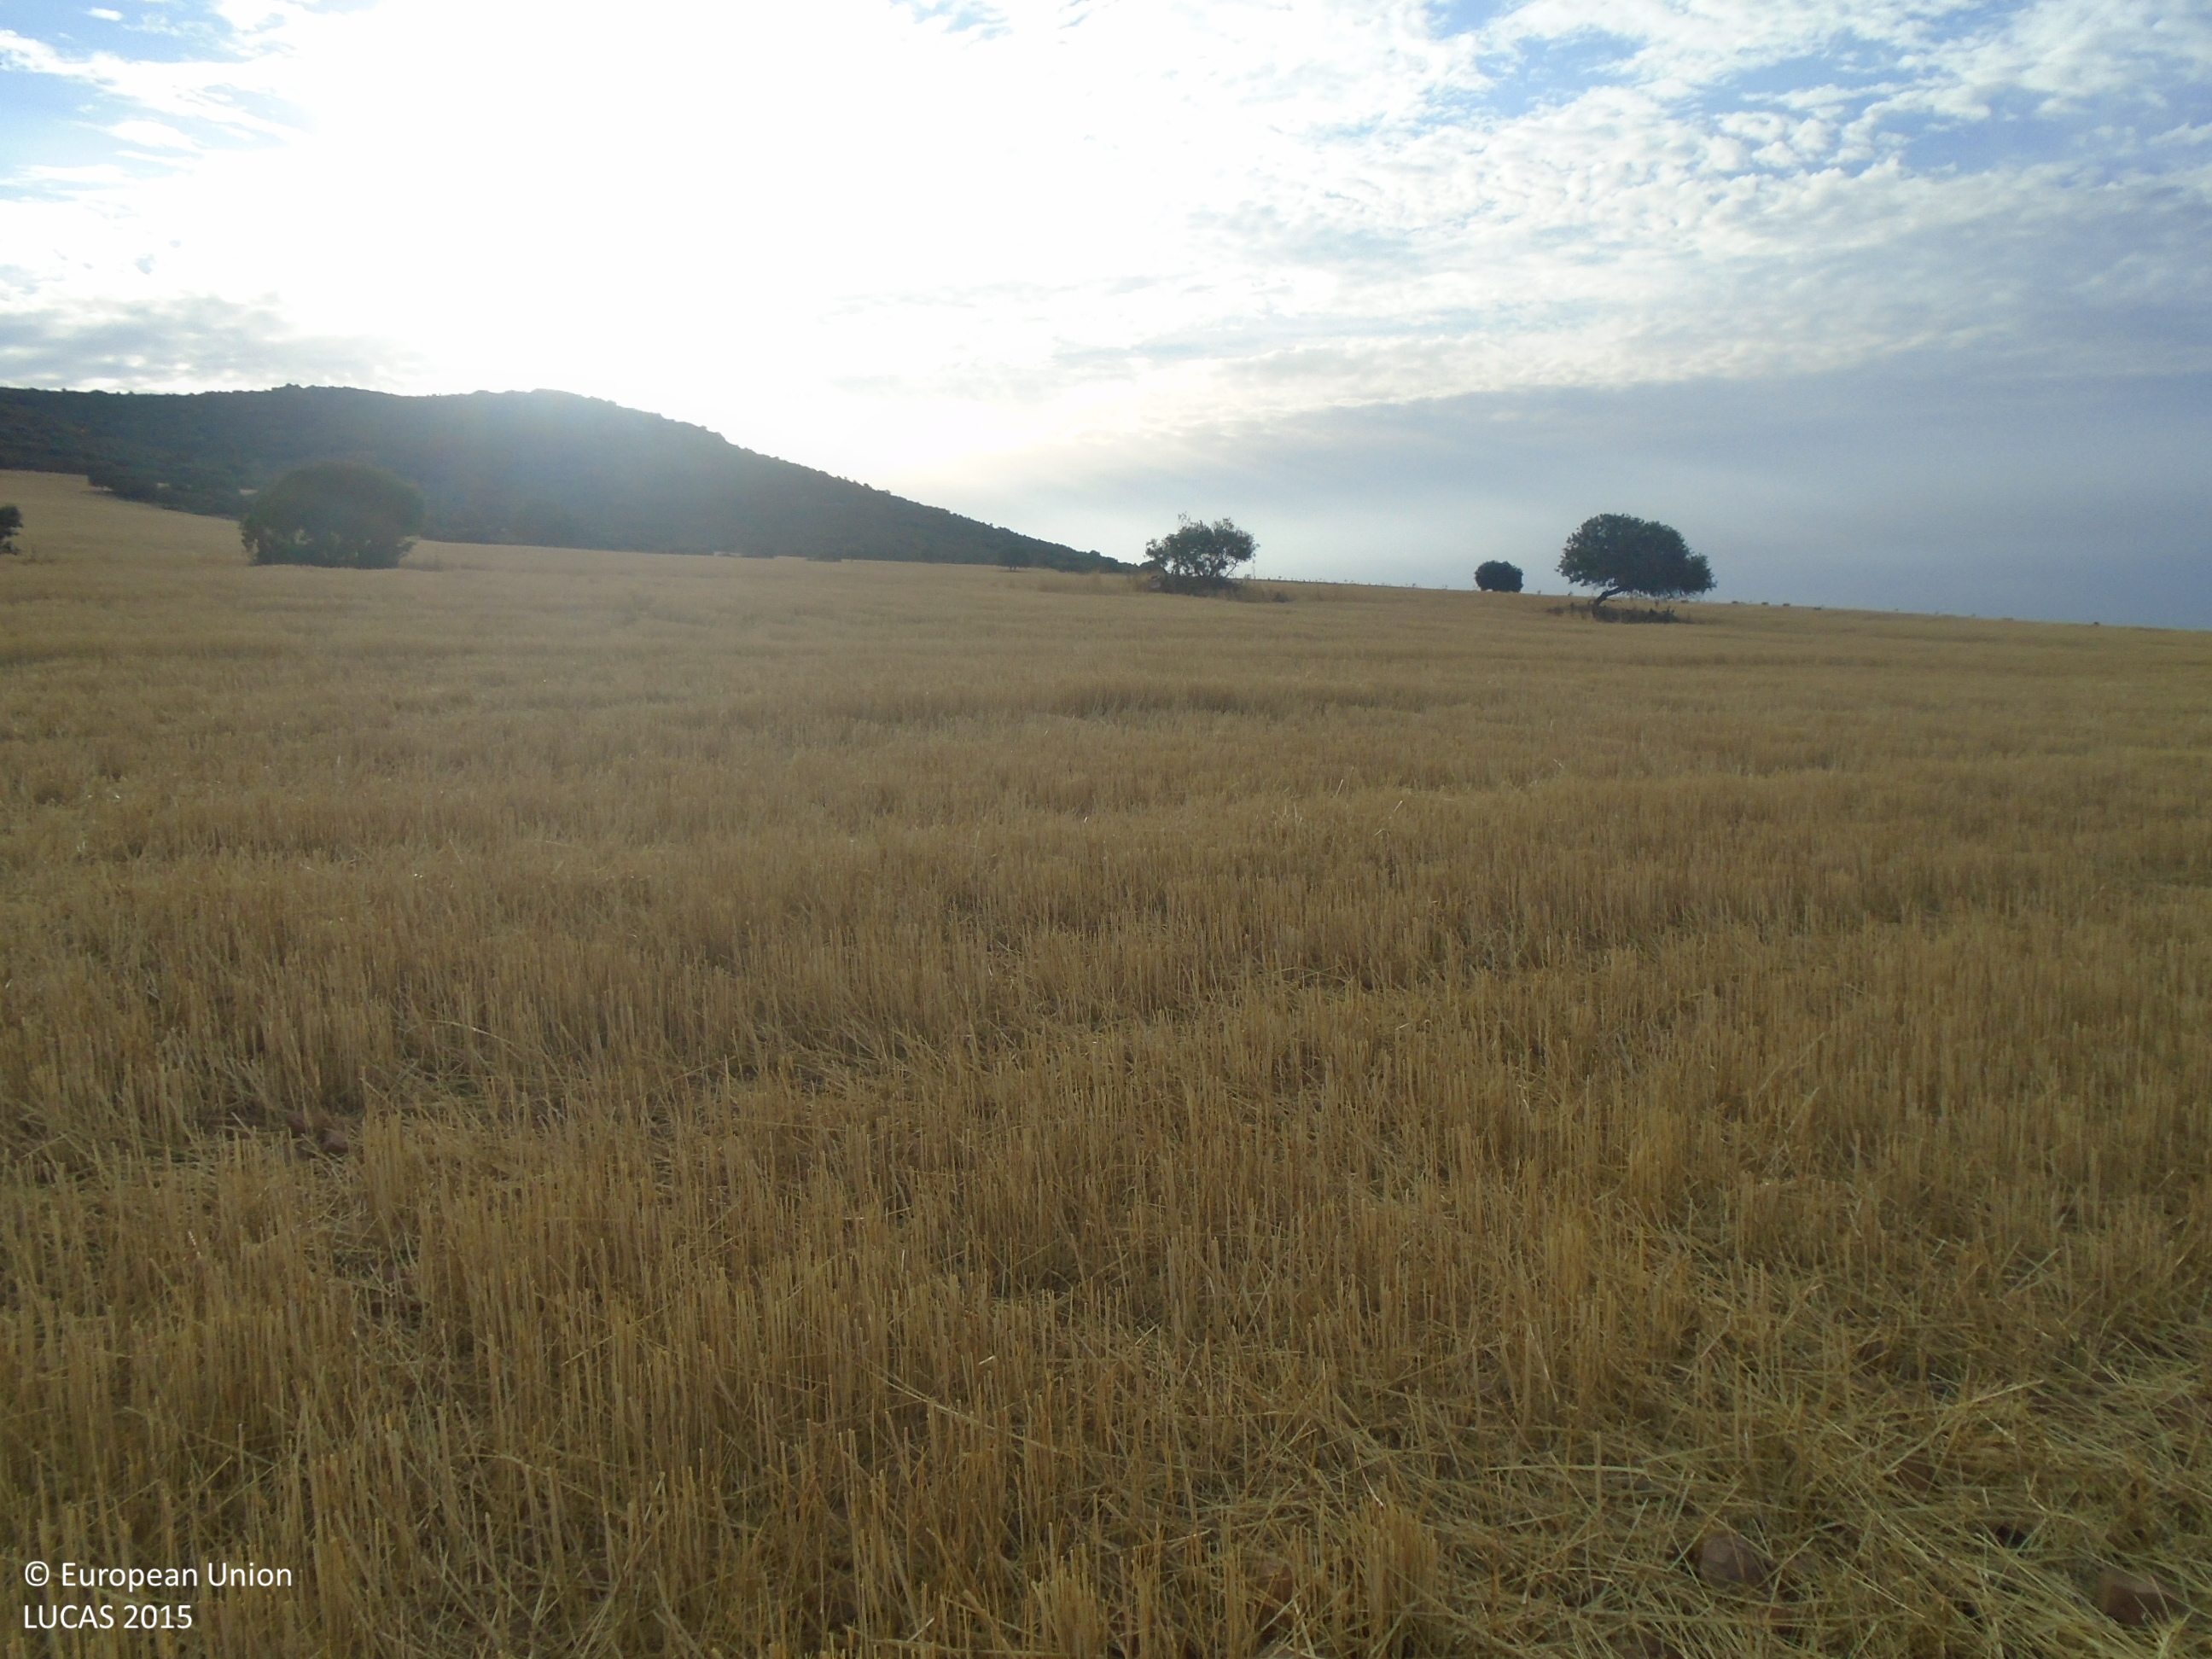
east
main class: Cropland
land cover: Common wheat
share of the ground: < 10 %
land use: Agriculture (excluding fallow land and kitchen gardens)
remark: Harvested field
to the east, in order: Common wheat; Abandoned hedges; Barley
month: July
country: ES
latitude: 39.2106
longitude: -4.0735
